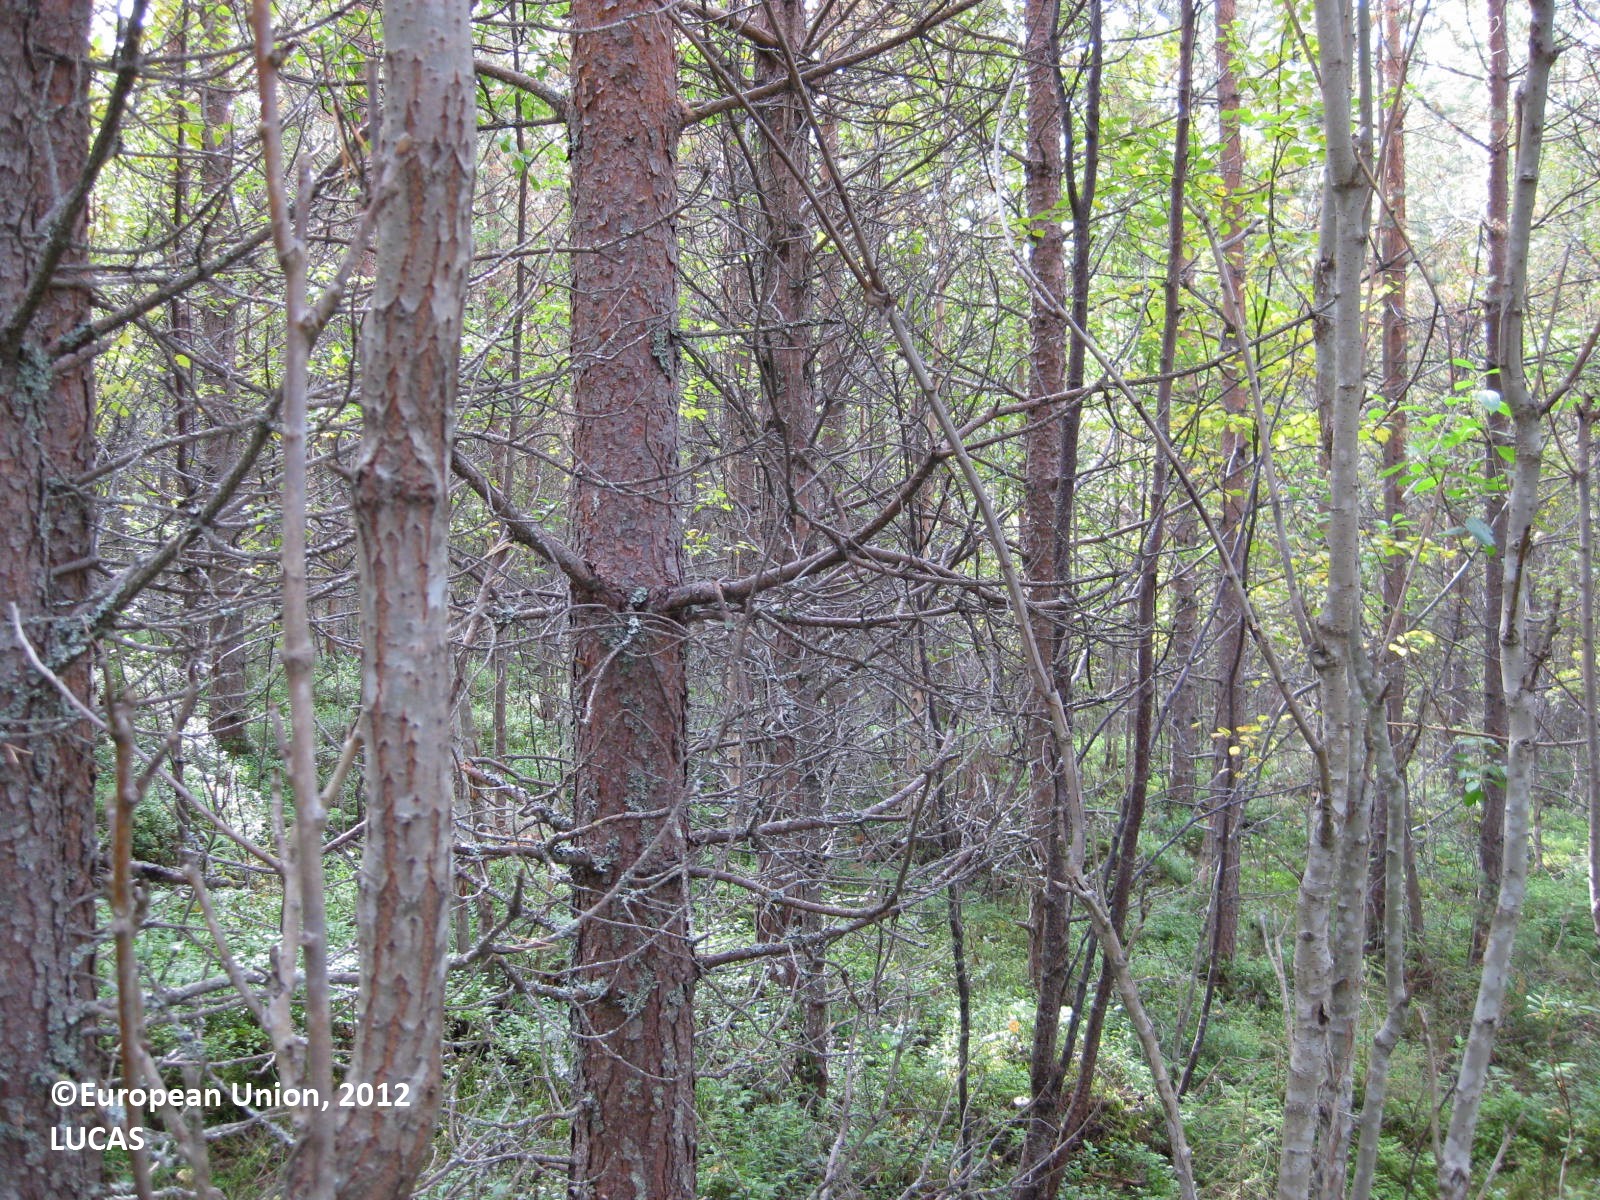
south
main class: Woodland
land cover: Pine dominated coniferous woodland
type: boreal forest
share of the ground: > 75 %
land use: Forestry
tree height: > 5 m
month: August
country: FI
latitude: 66.1574
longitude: 29.7747
